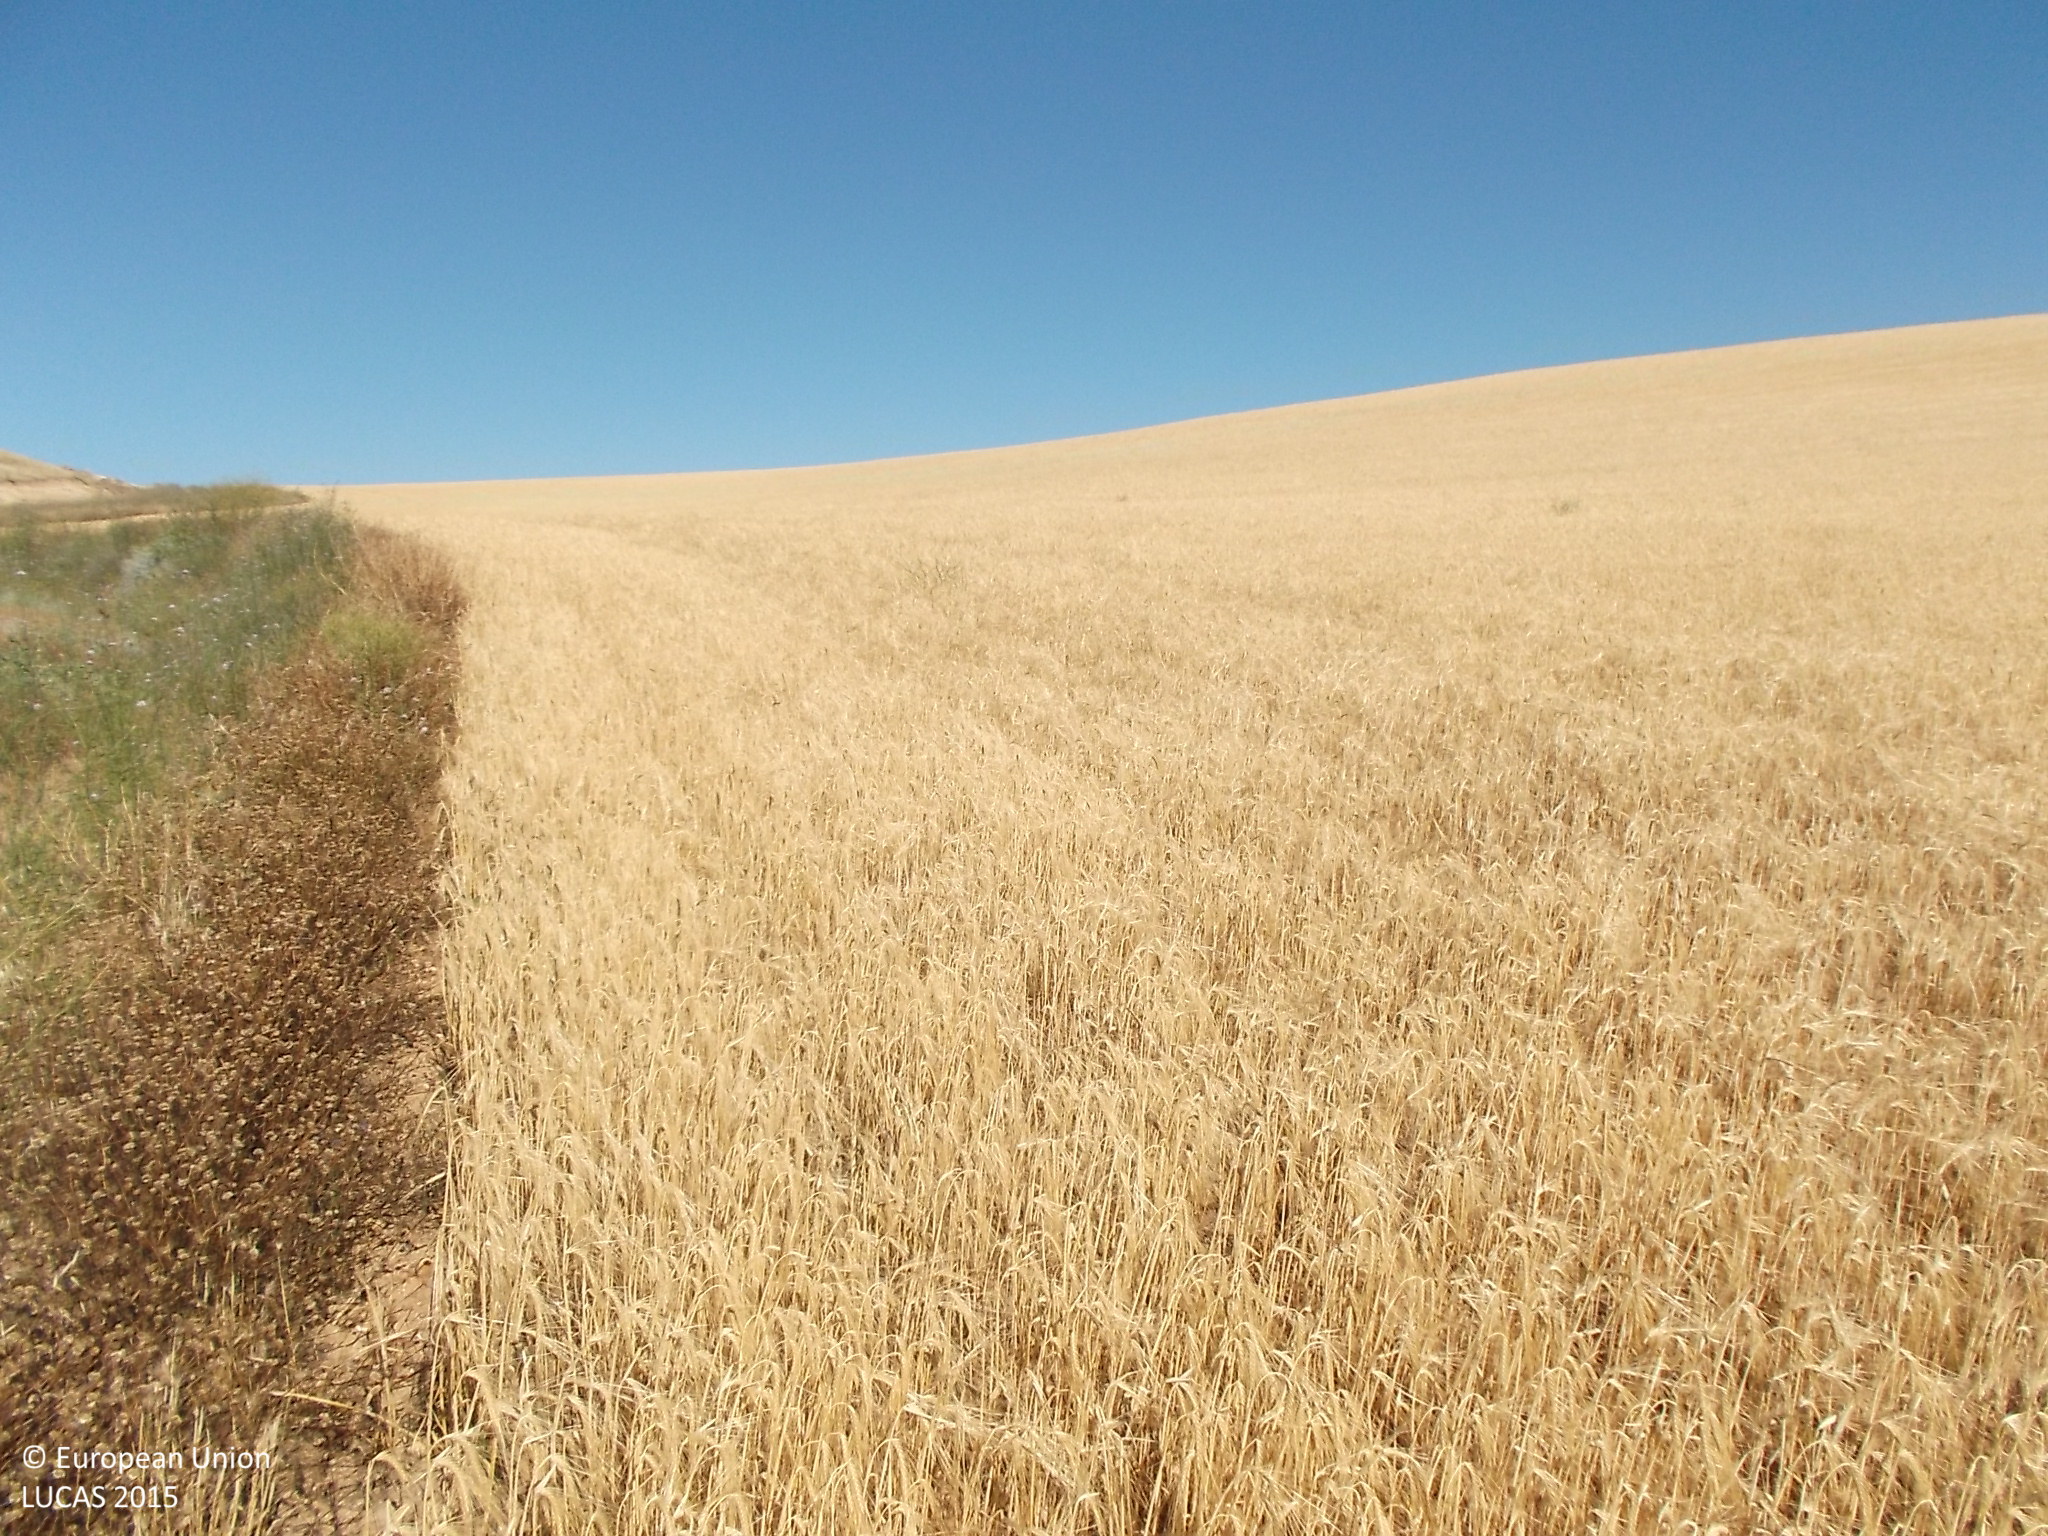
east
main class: Cropland
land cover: Barley
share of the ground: > 75 %
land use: Agriculture (excluding fallow land and kitchen gardens)
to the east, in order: Barley; Shruby margins; Barley; Other bare soil
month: June
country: ES
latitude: 41.3315
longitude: -5.3343
